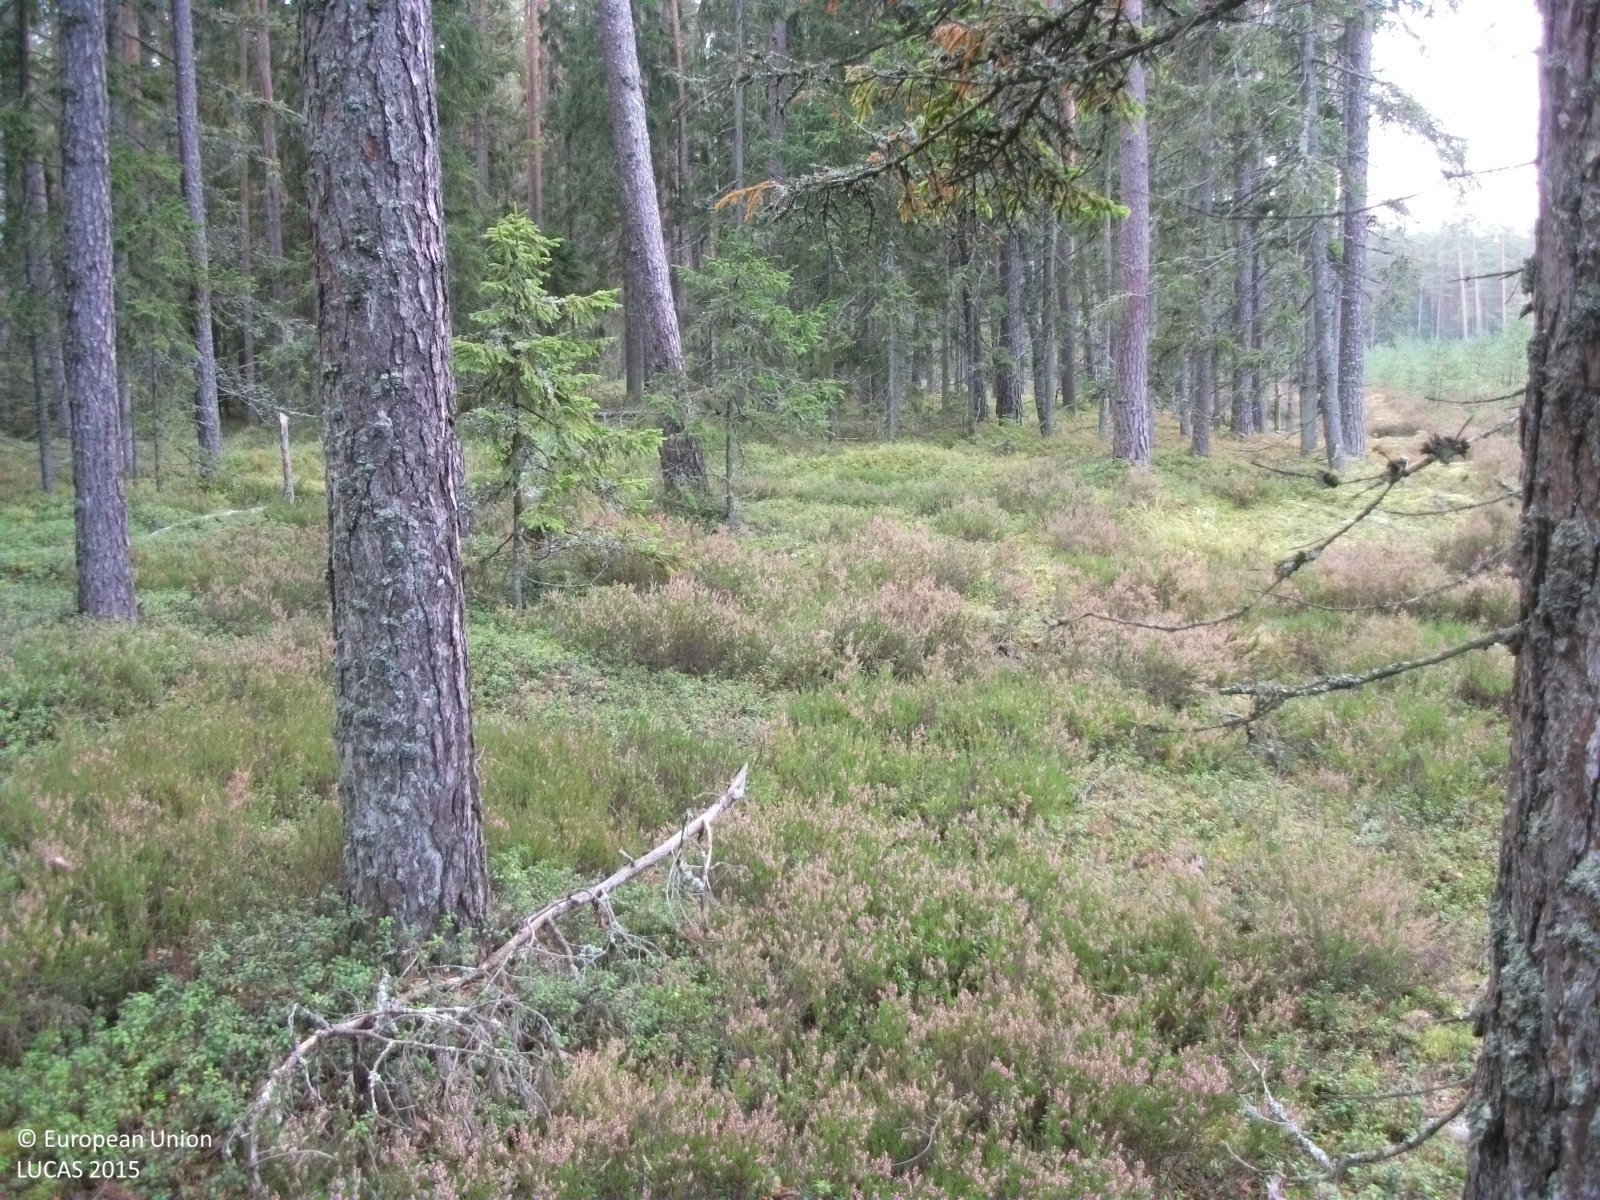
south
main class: Woodland
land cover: Pine dominated coniferous woodland
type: hemiboreal forest and nemoral coniferous forest and mixed broadleaved-coniferous forest
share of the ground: > 75 %
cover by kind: coniferous forest trees 80 %, lichens and mosses 15 %, herbaceous plants 5 %
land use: Forestry
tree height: > 5 m
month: September
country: LV
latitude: 57.6876
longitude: 24.4640
